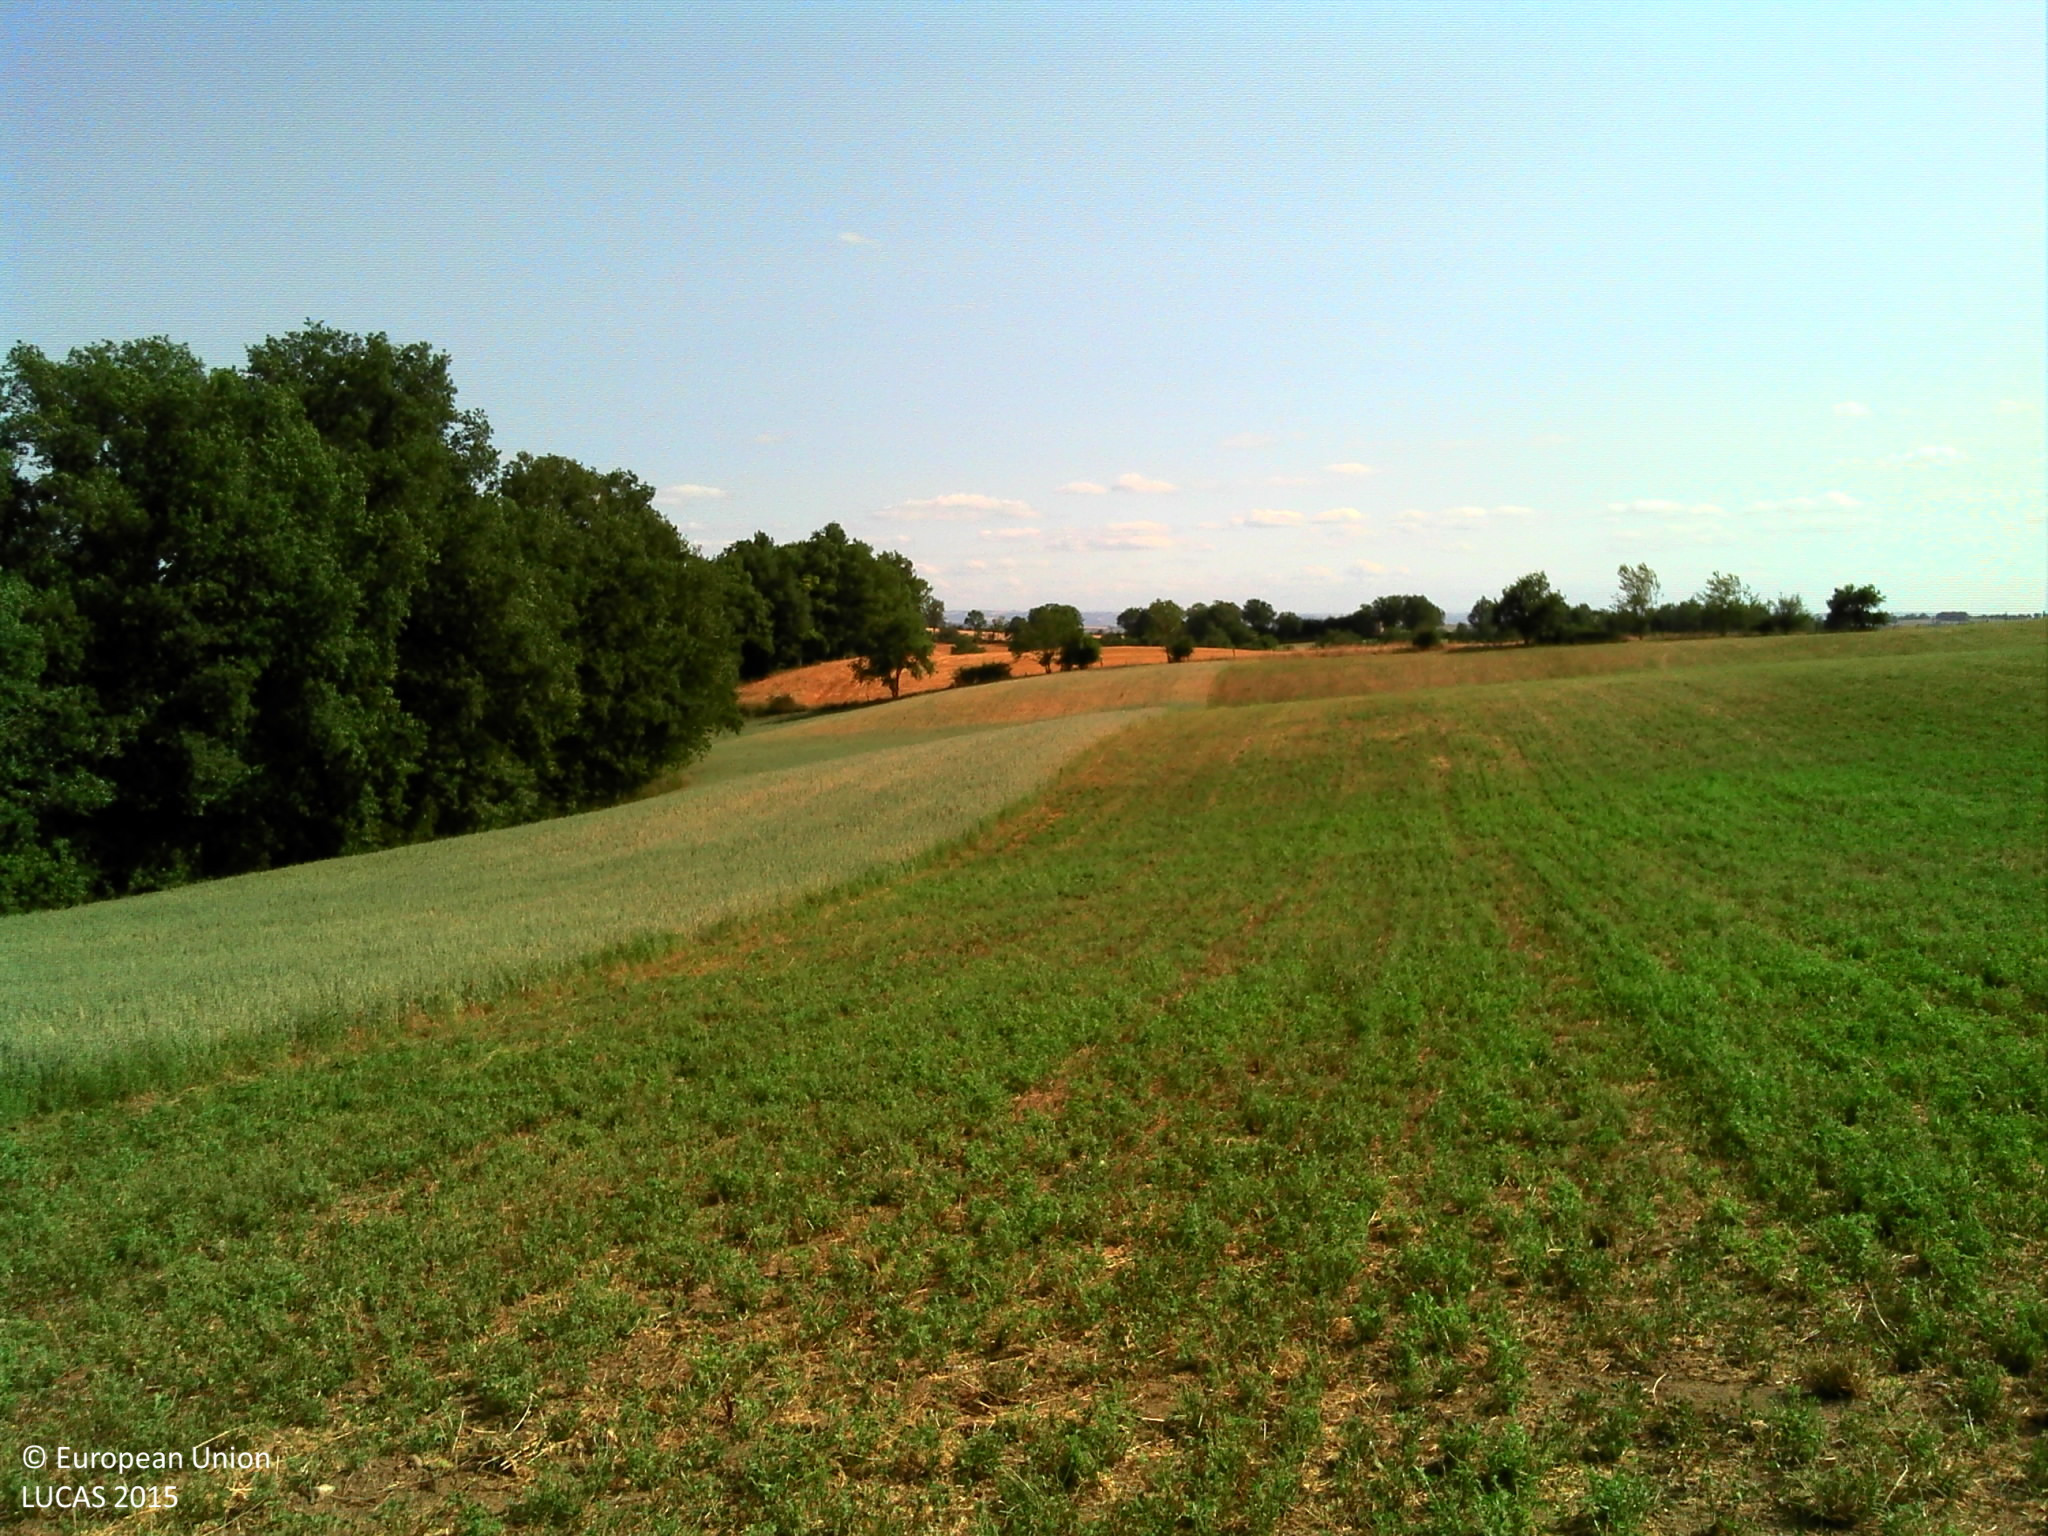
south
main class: Cropland
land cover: Lucerne
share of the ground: > 75 %
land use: Agriculture (excluding fallow land and kitchen gardens)
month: July
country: FR
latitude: 44.1399
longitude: 2.5917
